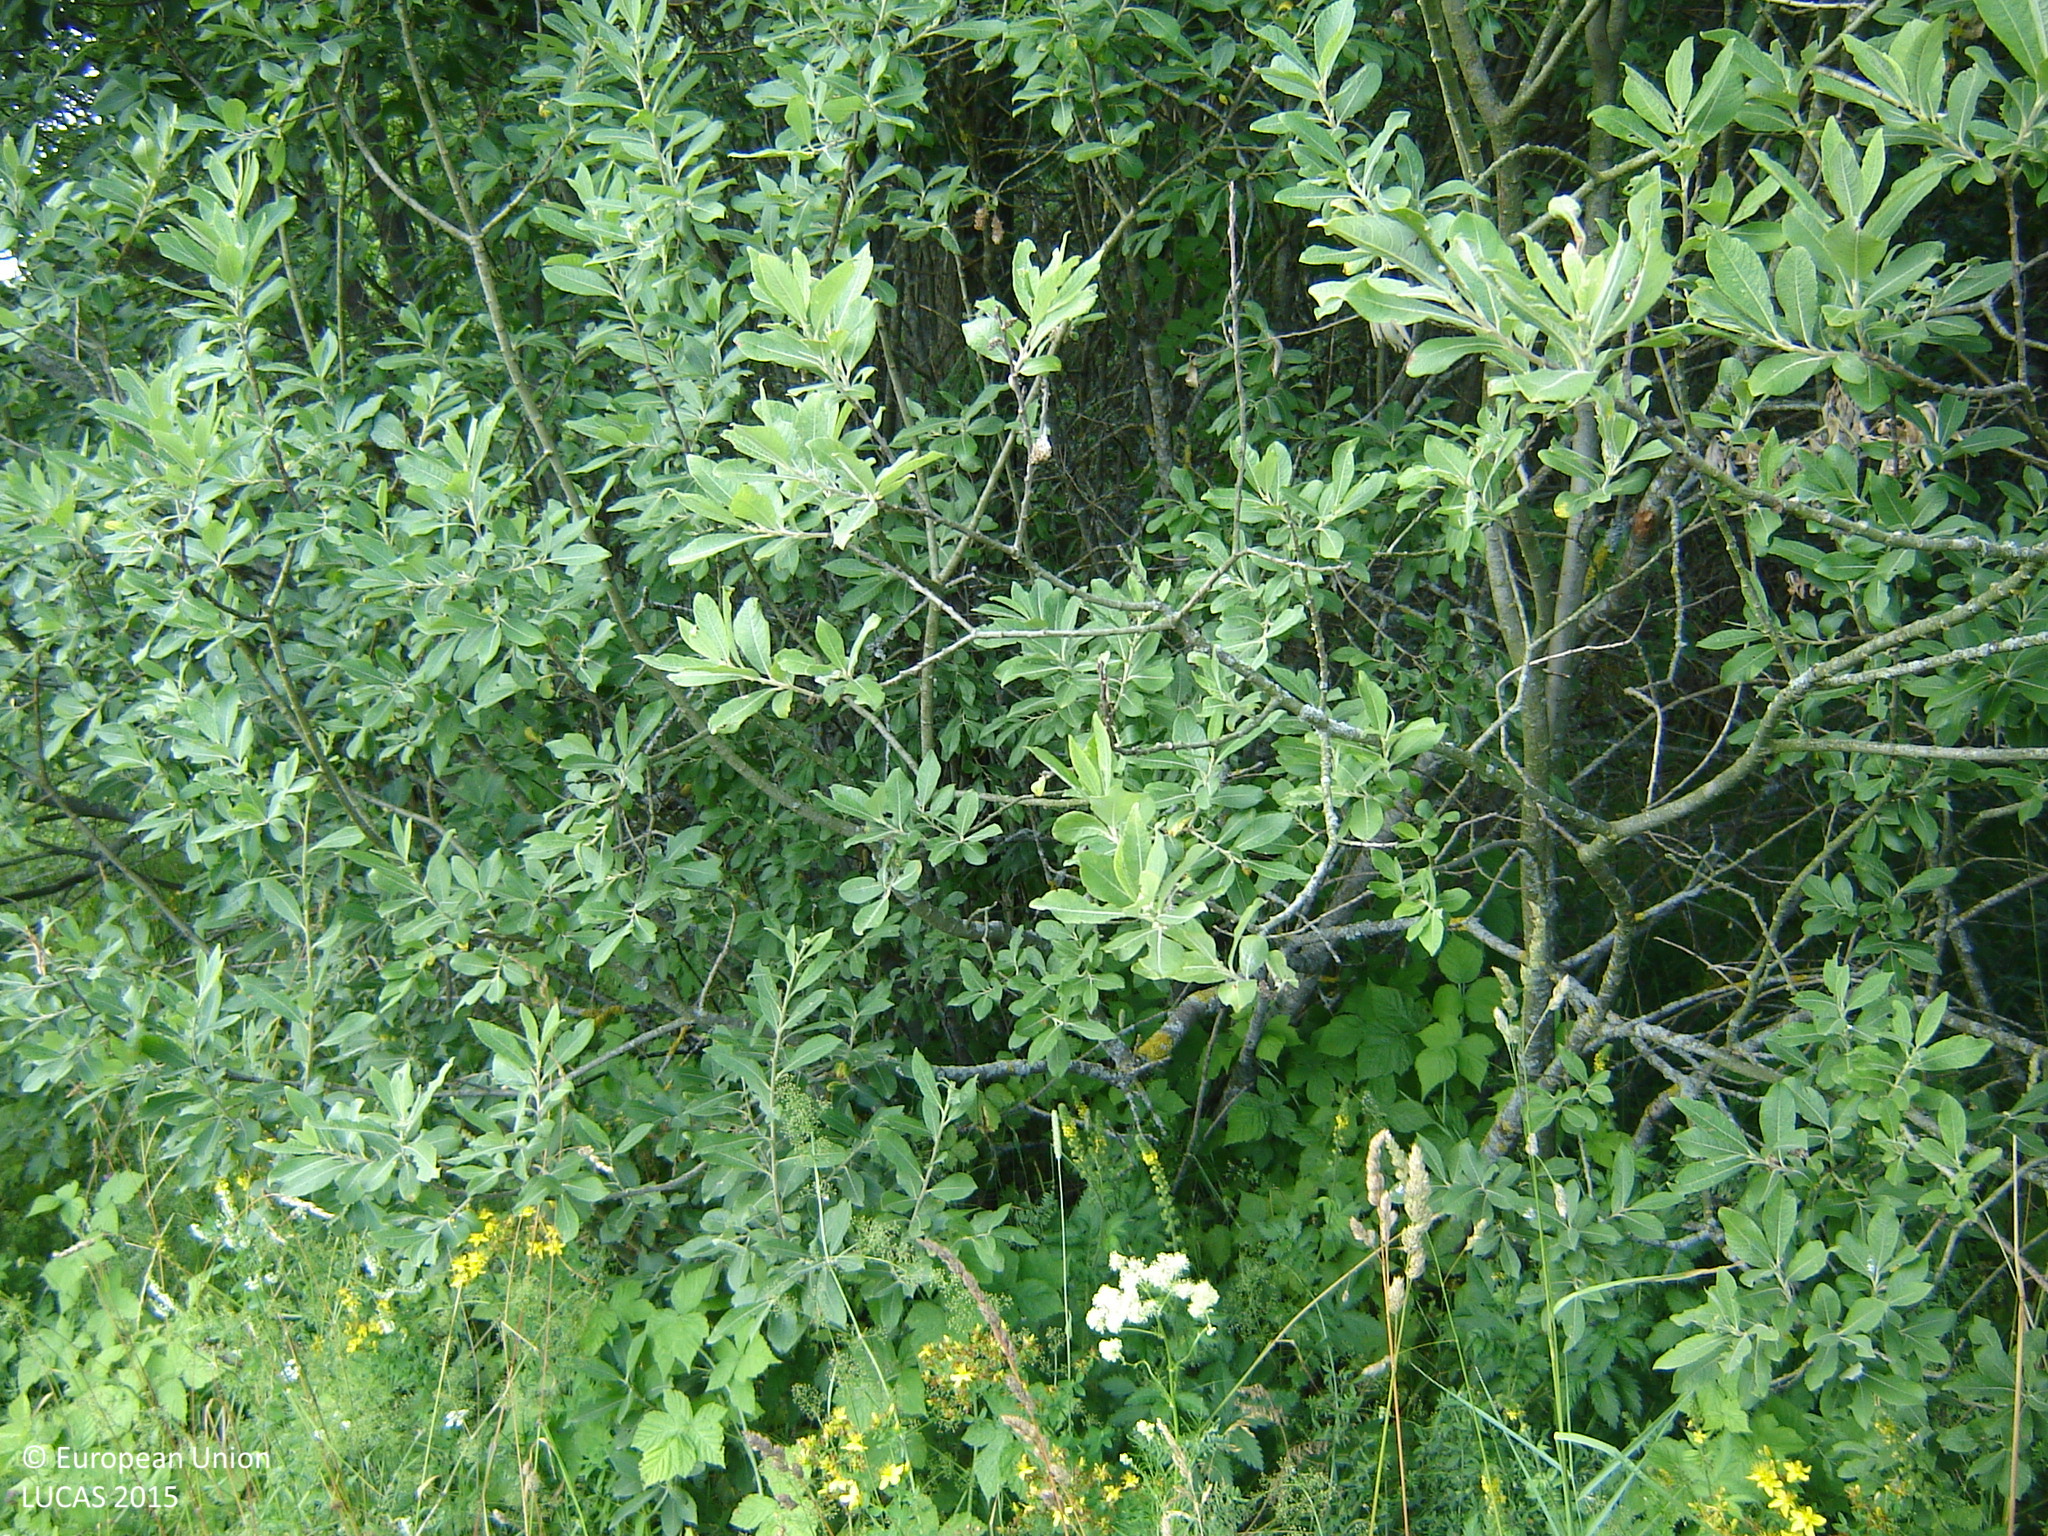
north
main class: Grassland
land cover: Grassland without tree/shrub cover
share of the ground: > 75 %
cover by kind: herbaceous plants 100 %
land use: Agriculture (excluding fallow land and kitchen gardens)
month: July
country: LT
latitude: 55.5018
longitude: 25.1393
